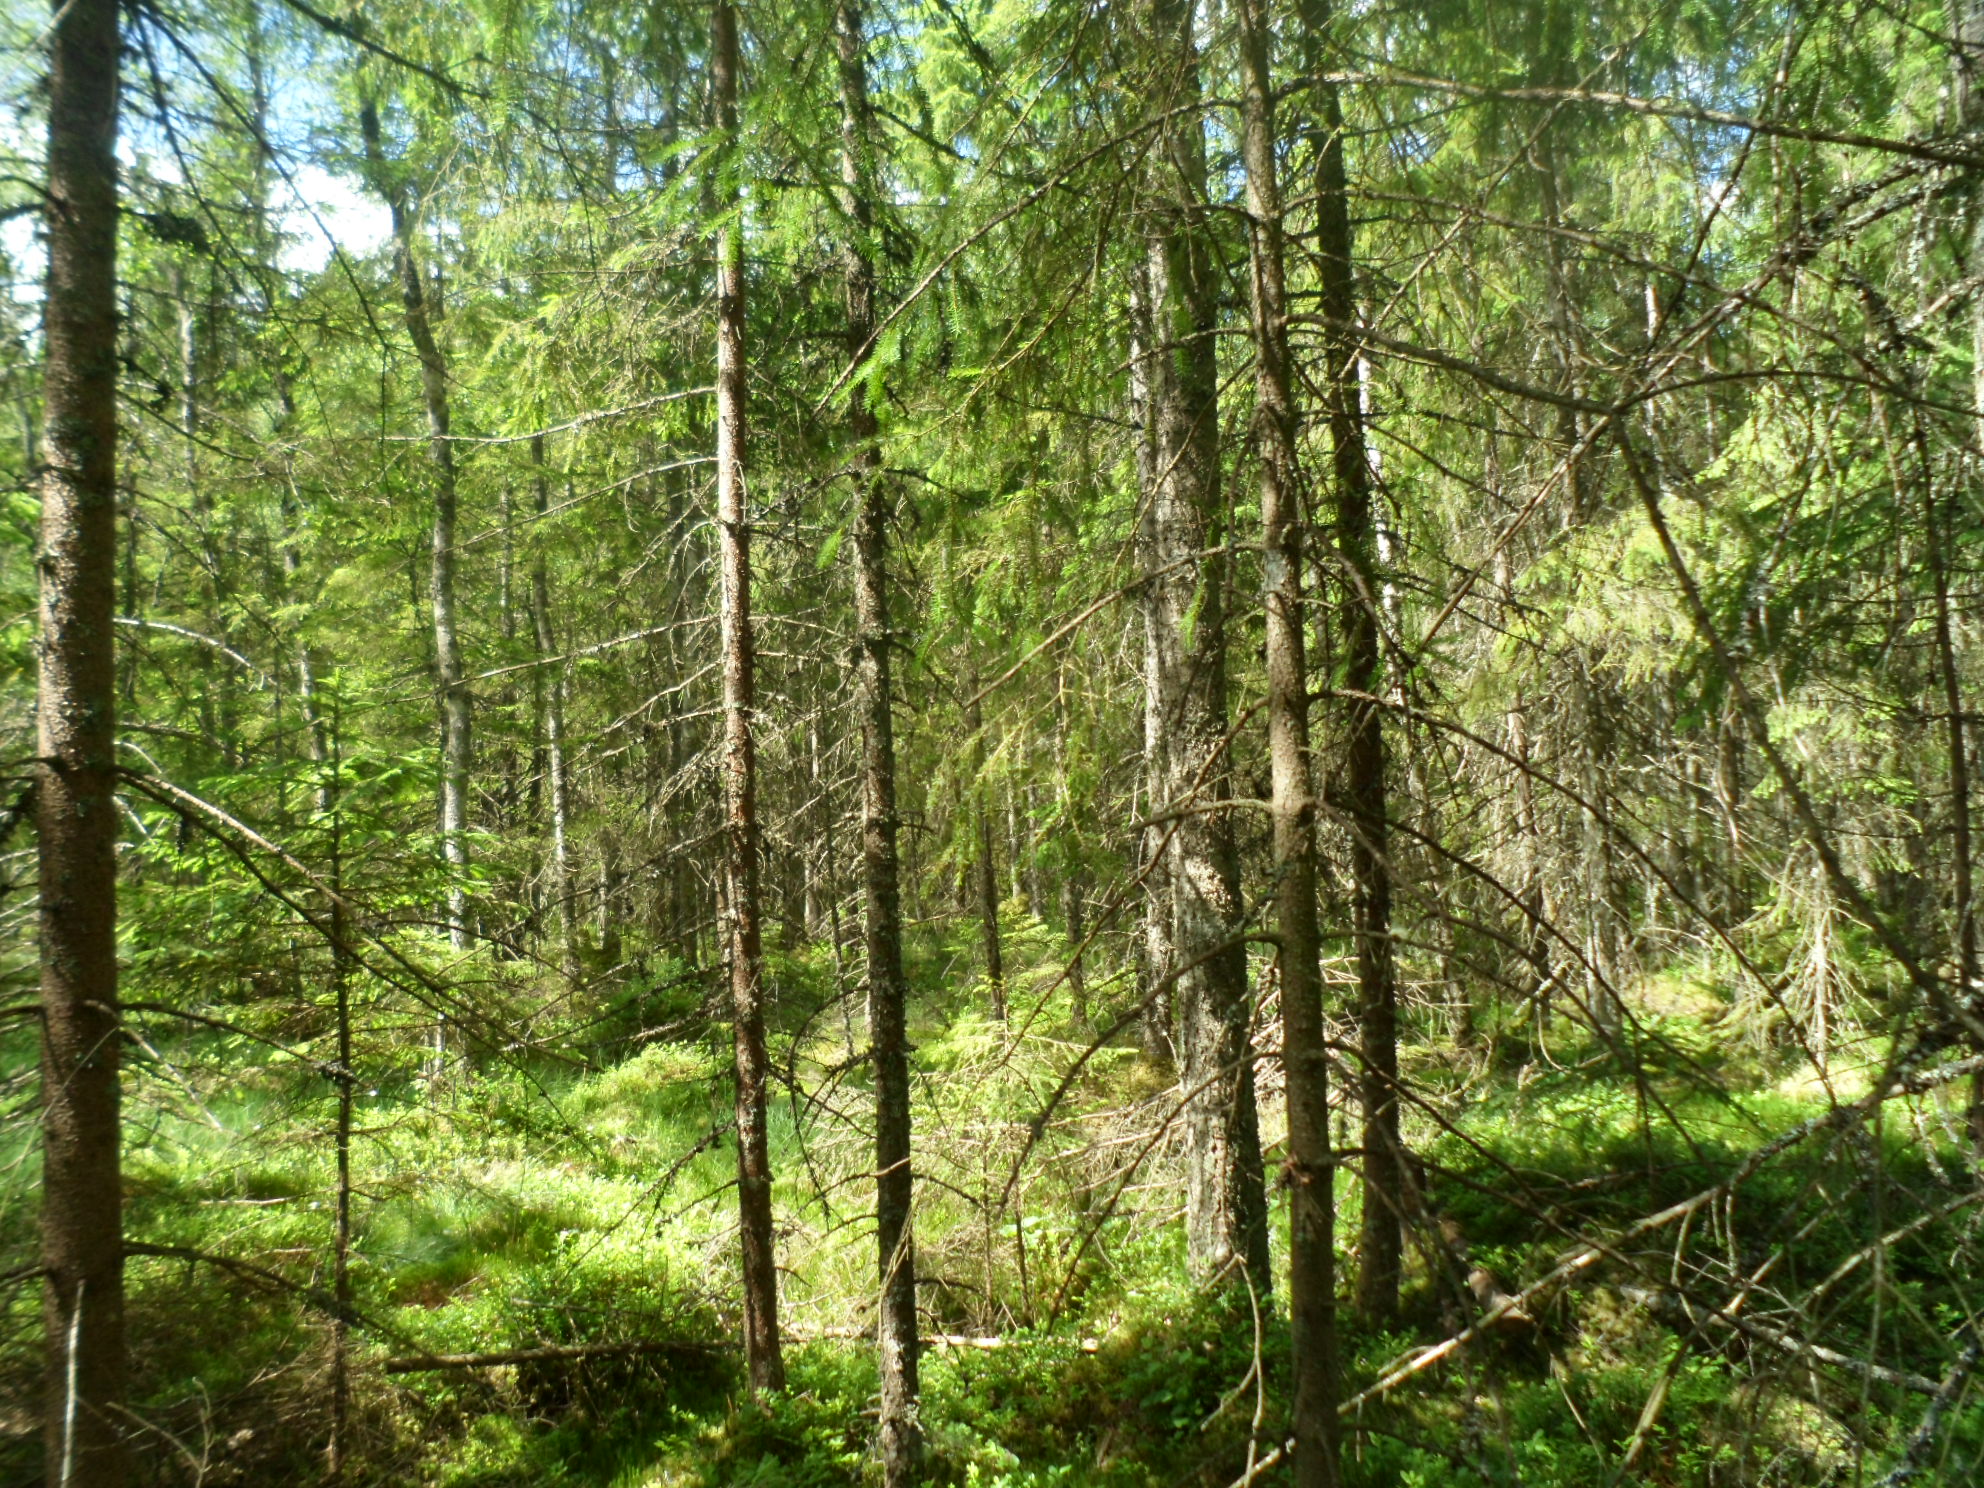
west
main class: Woodland
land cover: Spruce dominated coniferous woodland
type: boreal forest
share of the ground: 50 - 75 %
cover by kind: coniferous forest trees 65 %, shrubs 15 %, broadleaved forest trees 10 %, lichens and mosses 10 %
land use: Forestry
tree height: > 5 m
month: July
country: SE
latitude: 57.4065
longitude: 14.4732
